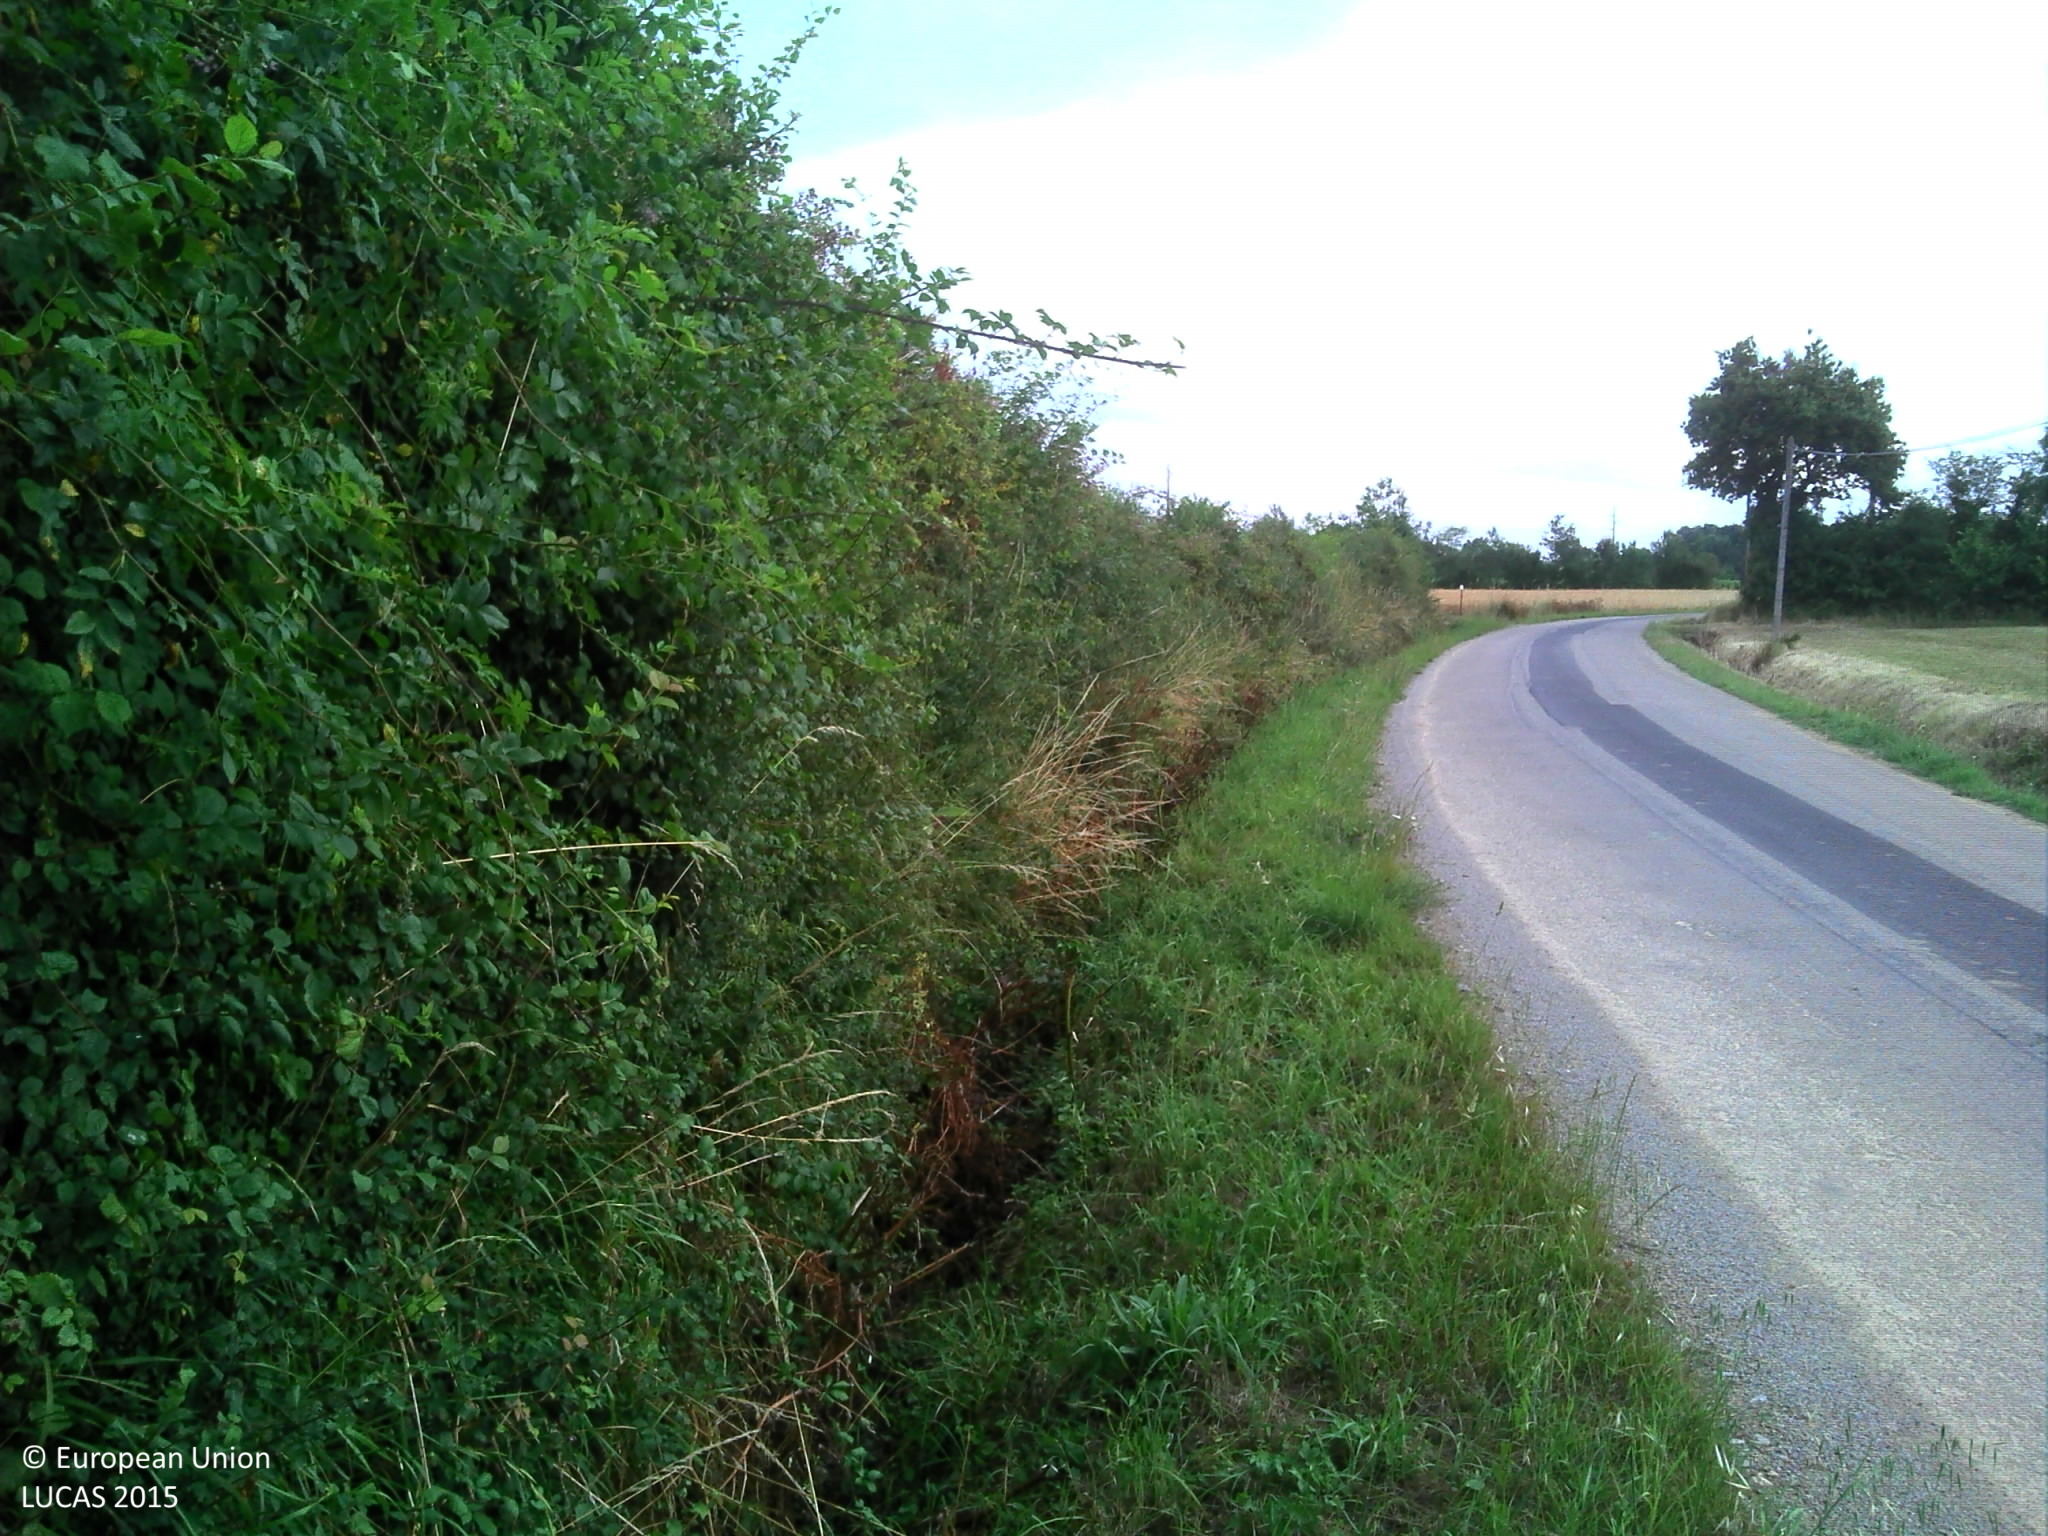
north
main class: Cropland
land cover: Temporary grasslands
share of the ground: > 75 %
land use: Agriculture (excluding fallow land and kitchen gardens)
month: July
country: FR
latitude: 47.1158
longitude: -1.7877
